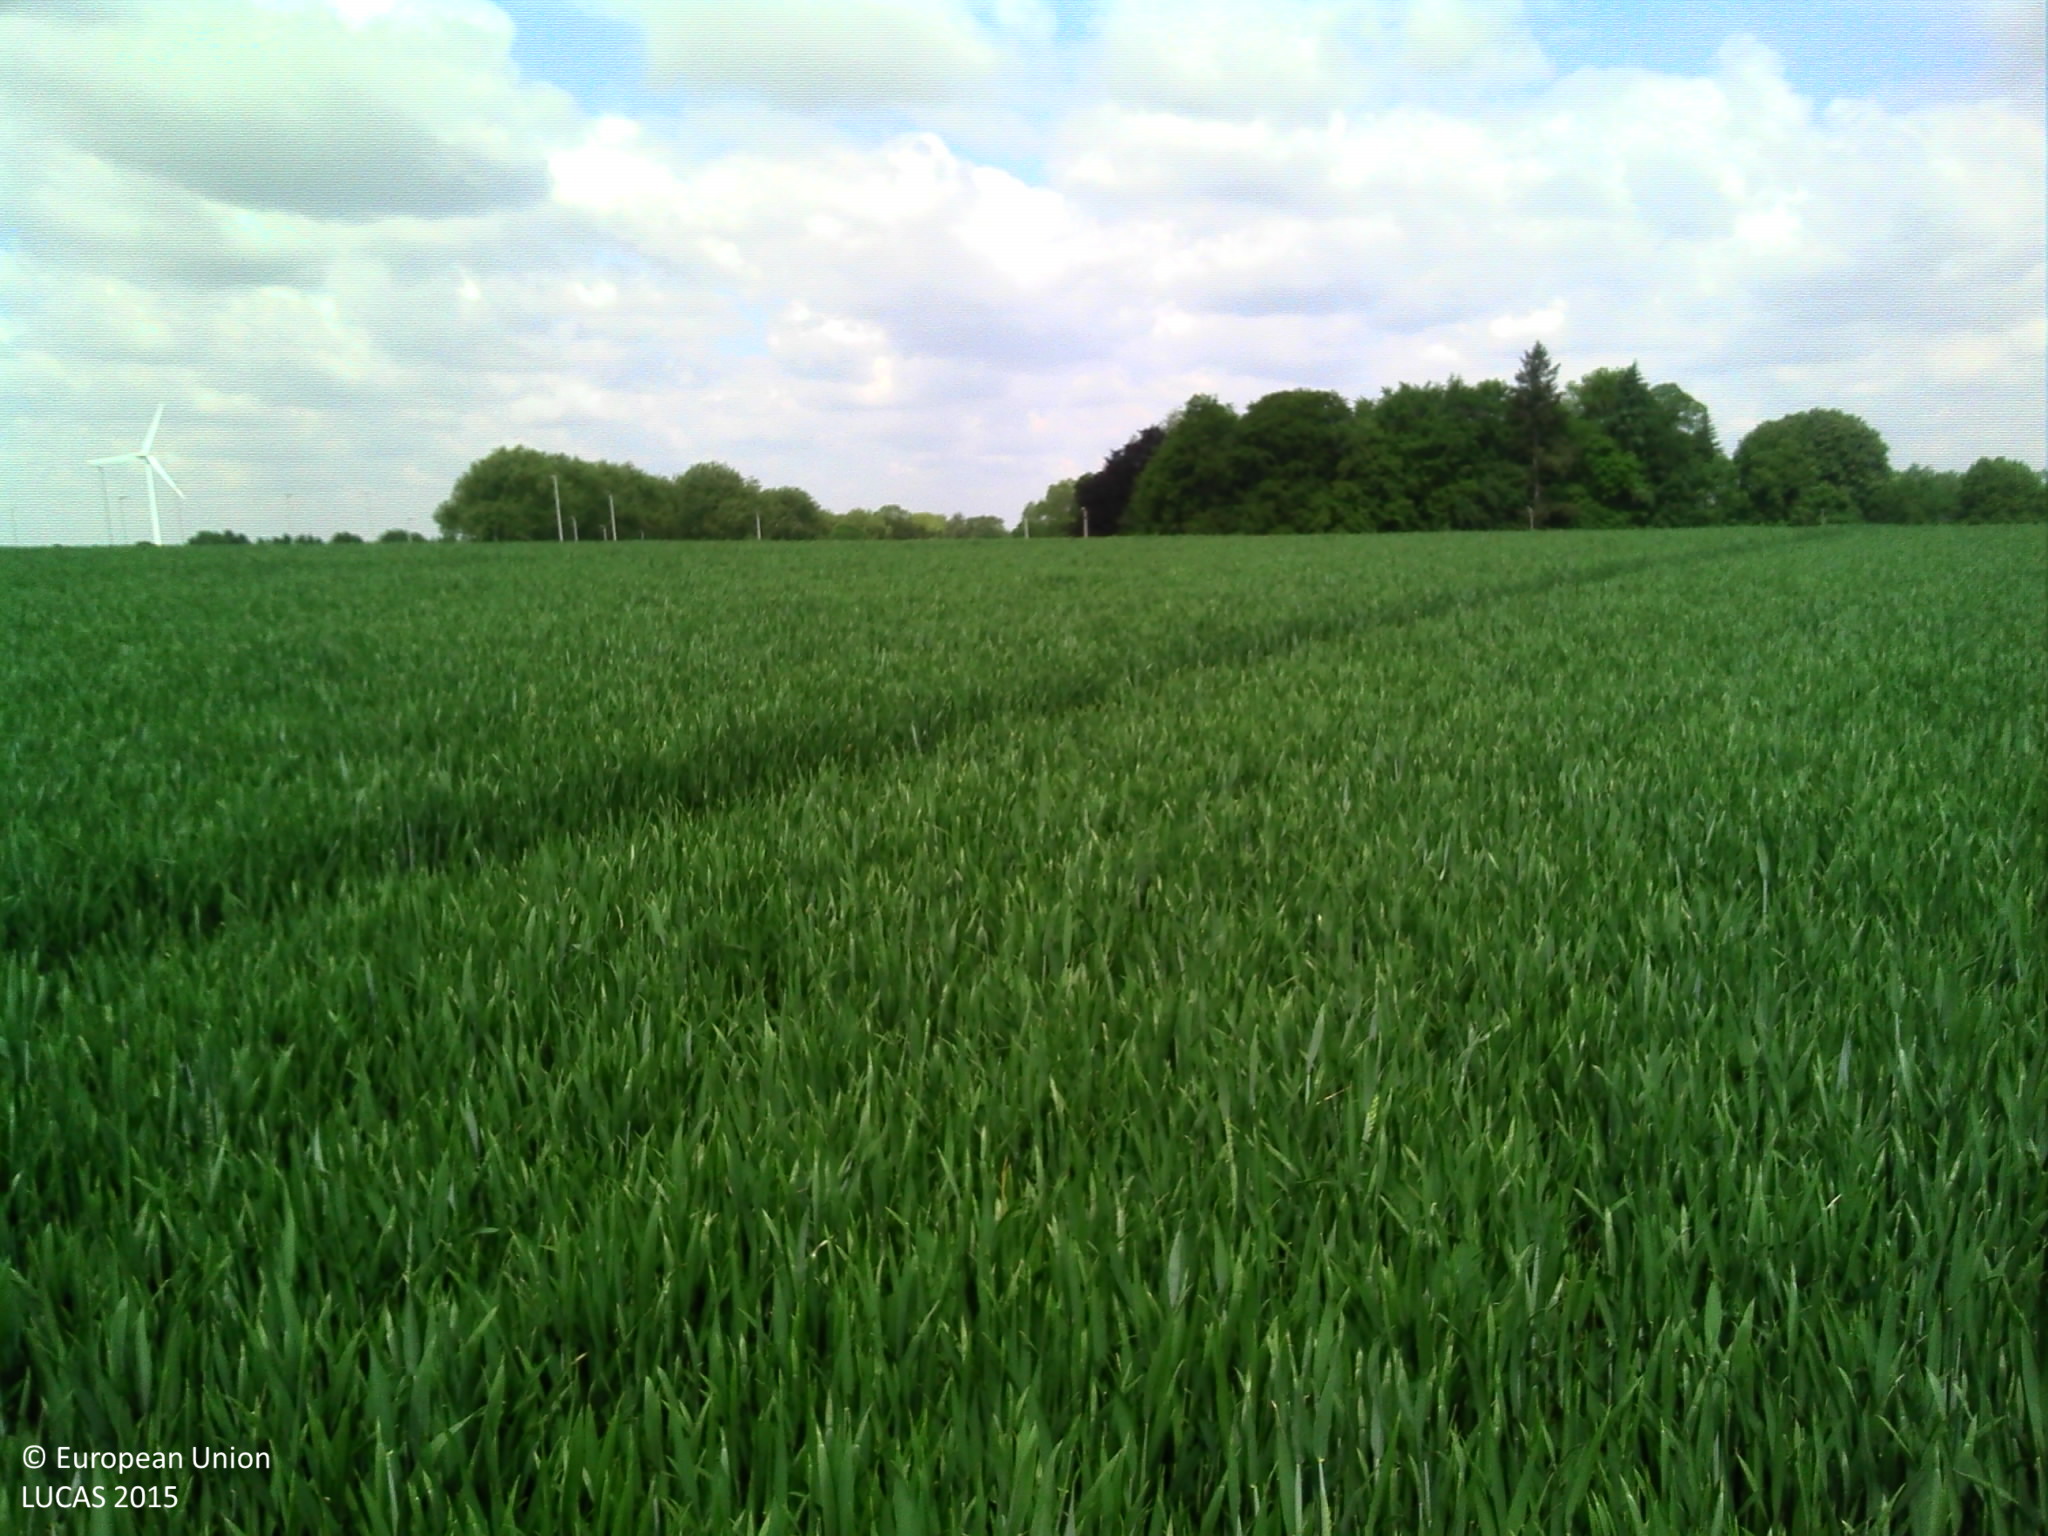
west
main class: Cropland
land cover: Common wheat
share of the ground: > 75 %
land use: Agriculture (excluding fallow land and kitchen gardens)
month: May
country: BE
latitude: 50.5399
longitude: 4.5353
